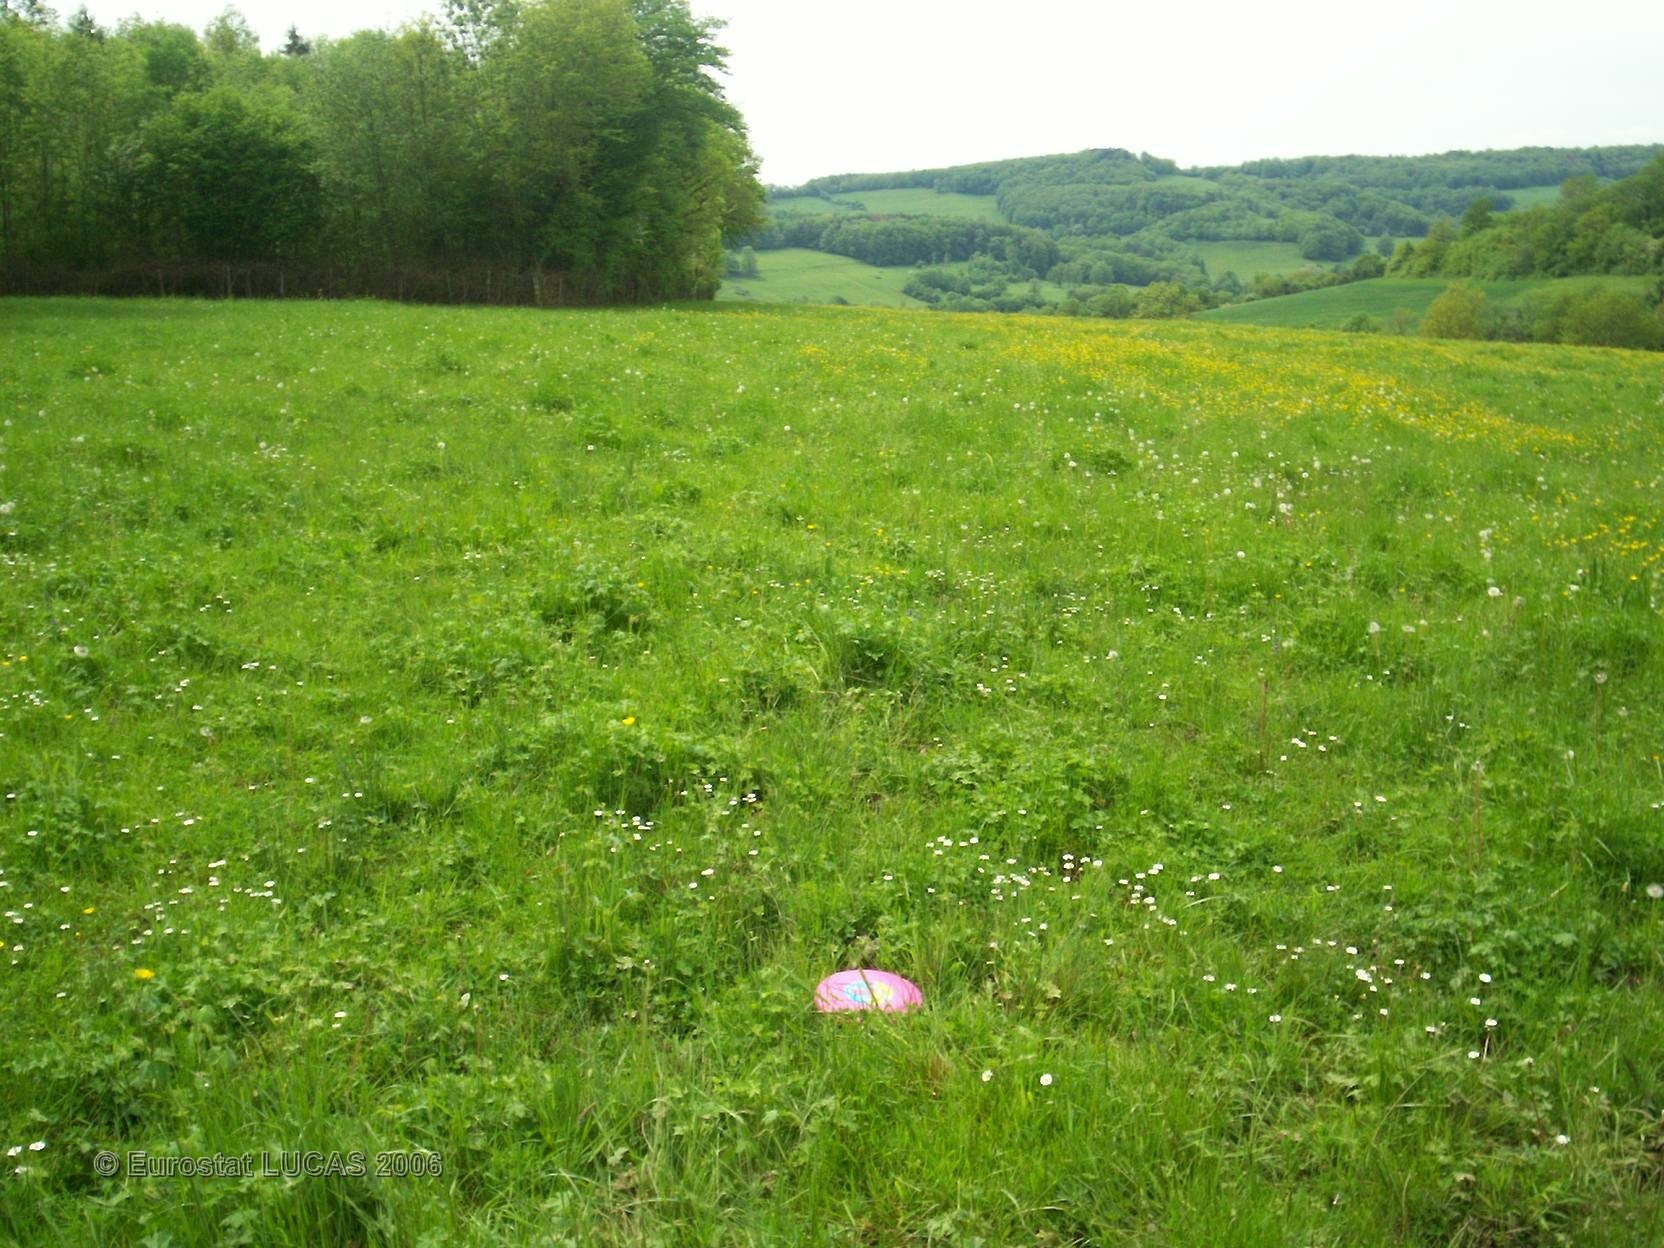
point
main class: Grassland
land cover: Grassland without tree/shrub cover
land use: Agriculture (excluding fallow land and kitchen gardens)
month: May
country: FR
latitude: 47.3164
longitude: 4.6154
